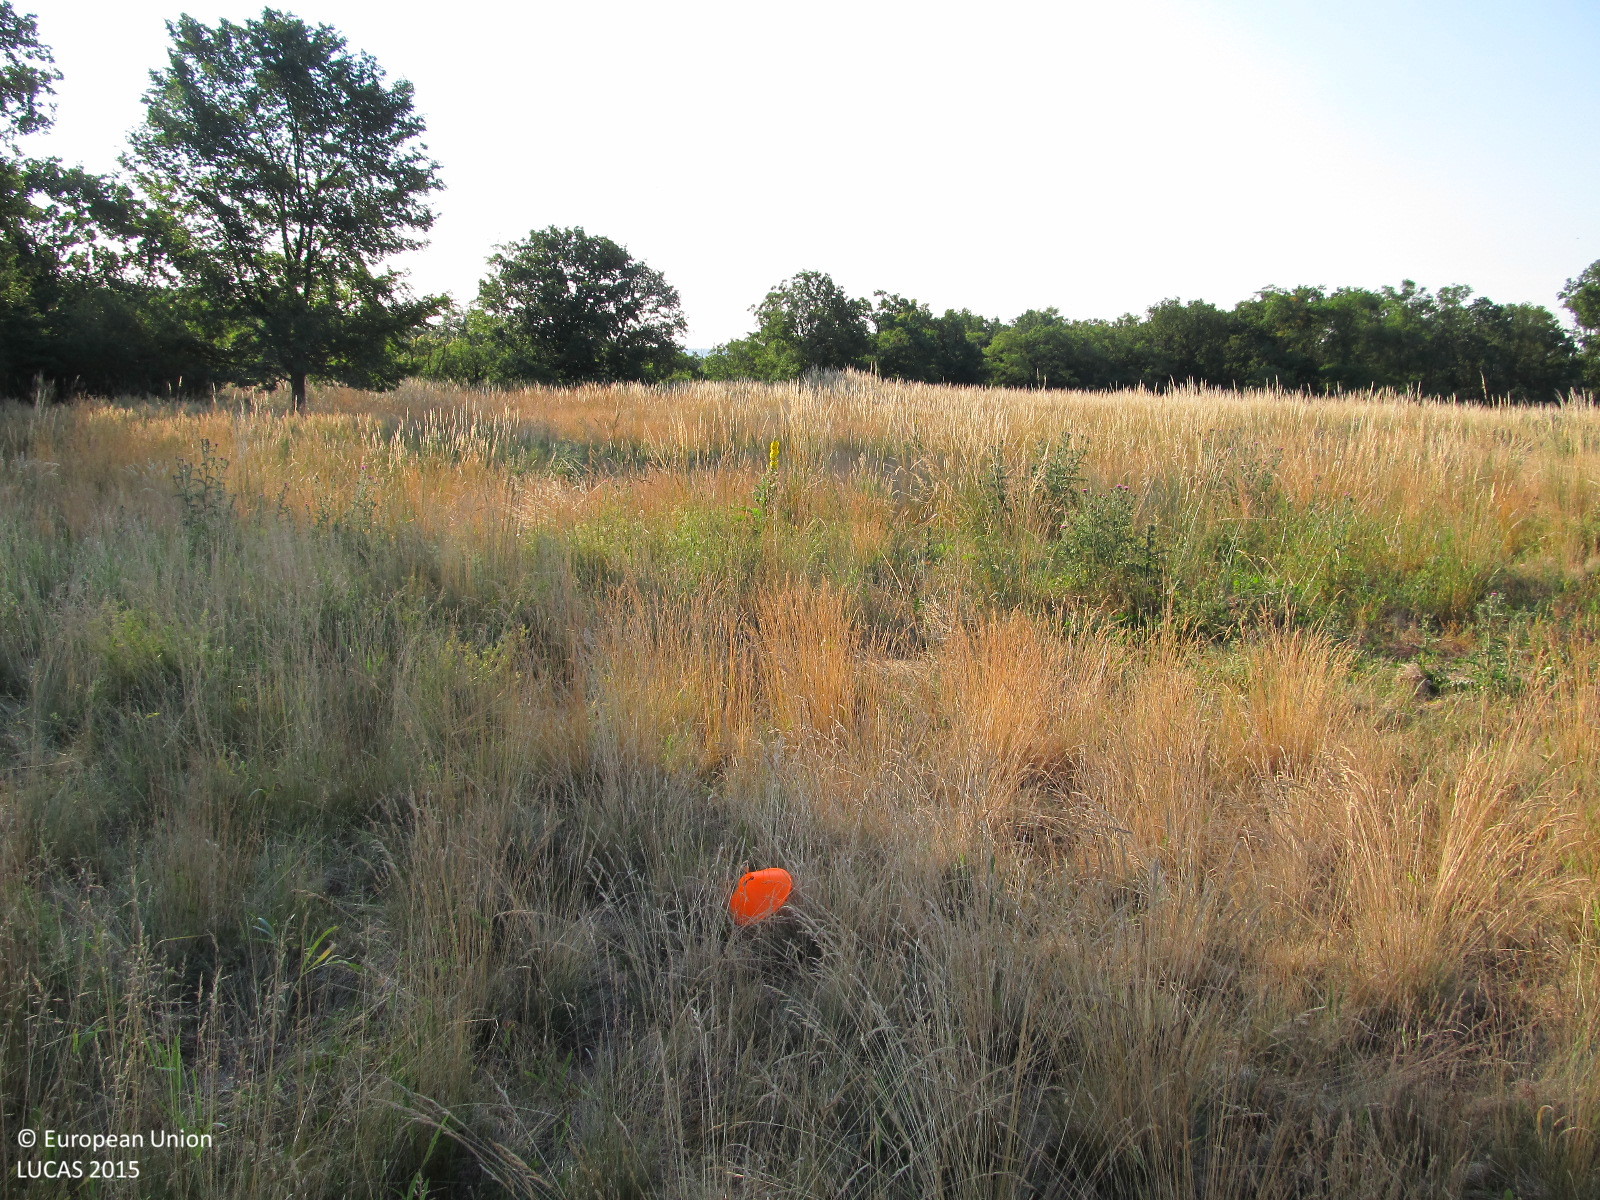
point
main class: Grassland
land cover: Grassland without tree/shrub cover
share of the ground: > 75 %
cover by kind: herbaceous plants 100 %
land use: Agriculture (excluding fallow land and kitchen gardens)
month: July
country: AT
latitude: 48.6551
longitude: 15.6643
